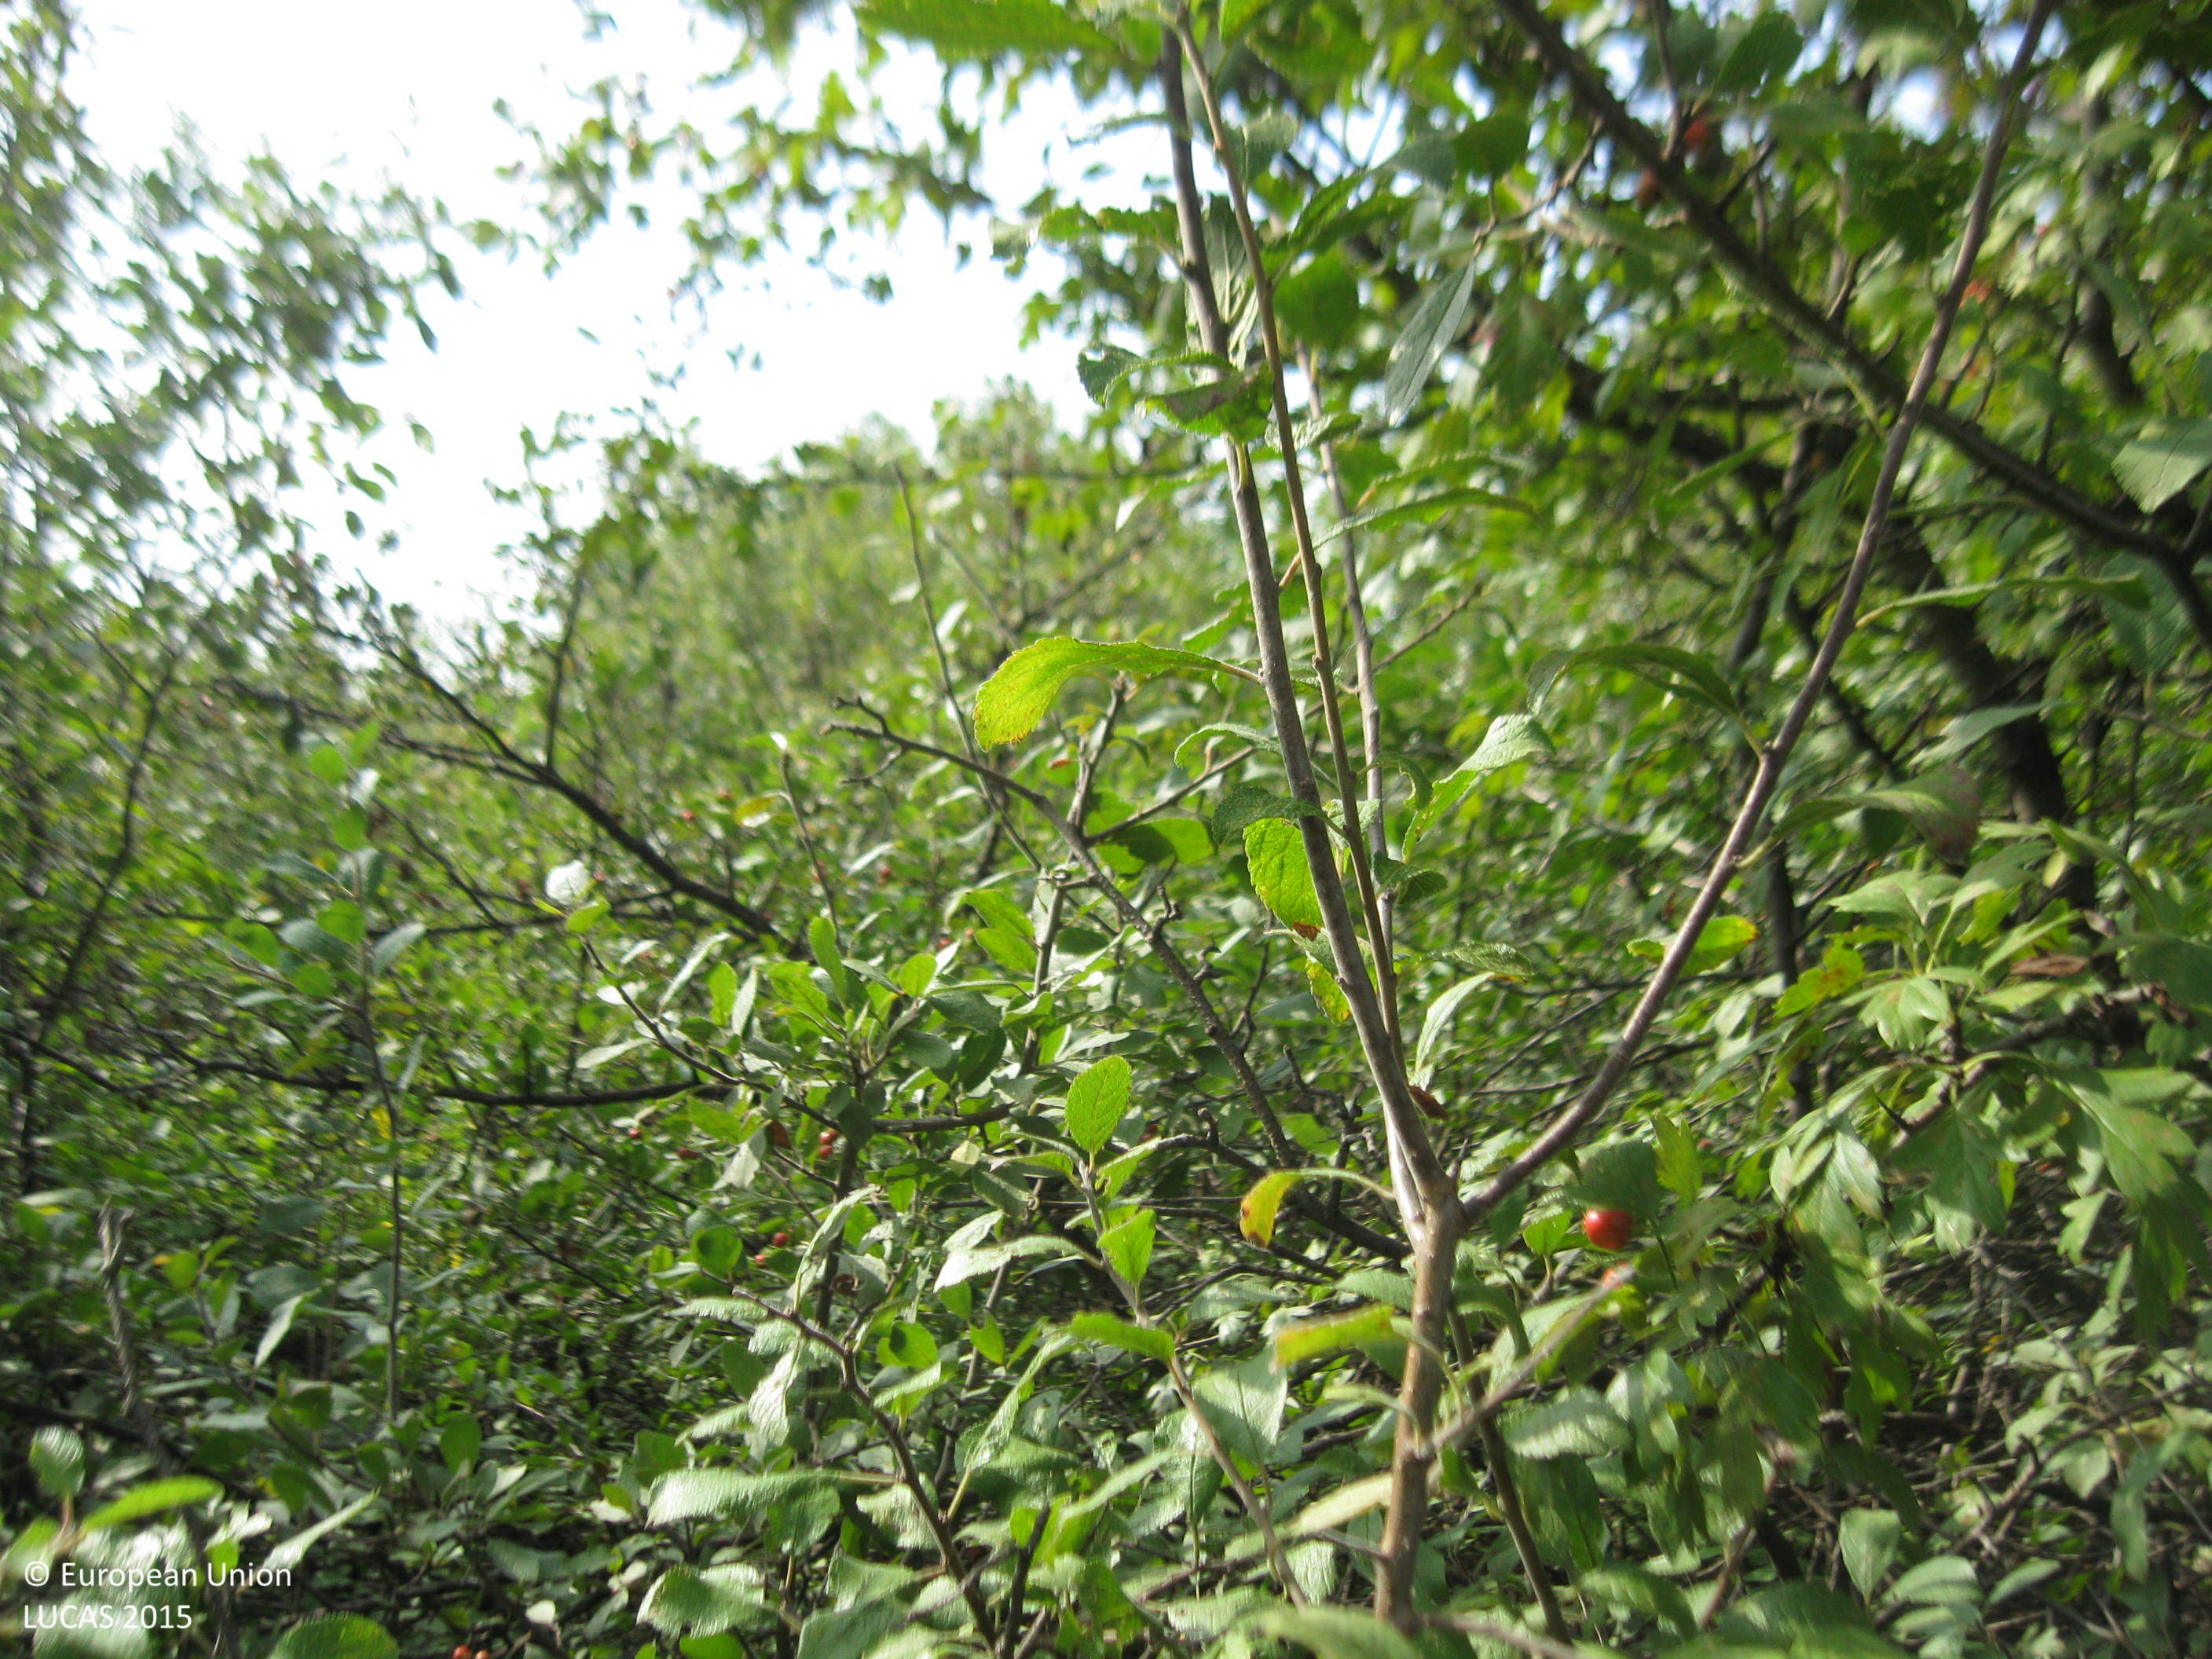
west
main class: Shrubland
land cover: Shrubland with sparse tree cover
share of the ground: > 75 %
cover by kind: shrubs 90 %, broadleaved forest trees 5 %, herbaceous plants 5 %
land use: Abandoned areas
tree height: < 5 m
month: September
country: BG
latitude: 42.1175
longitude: 24.9930
